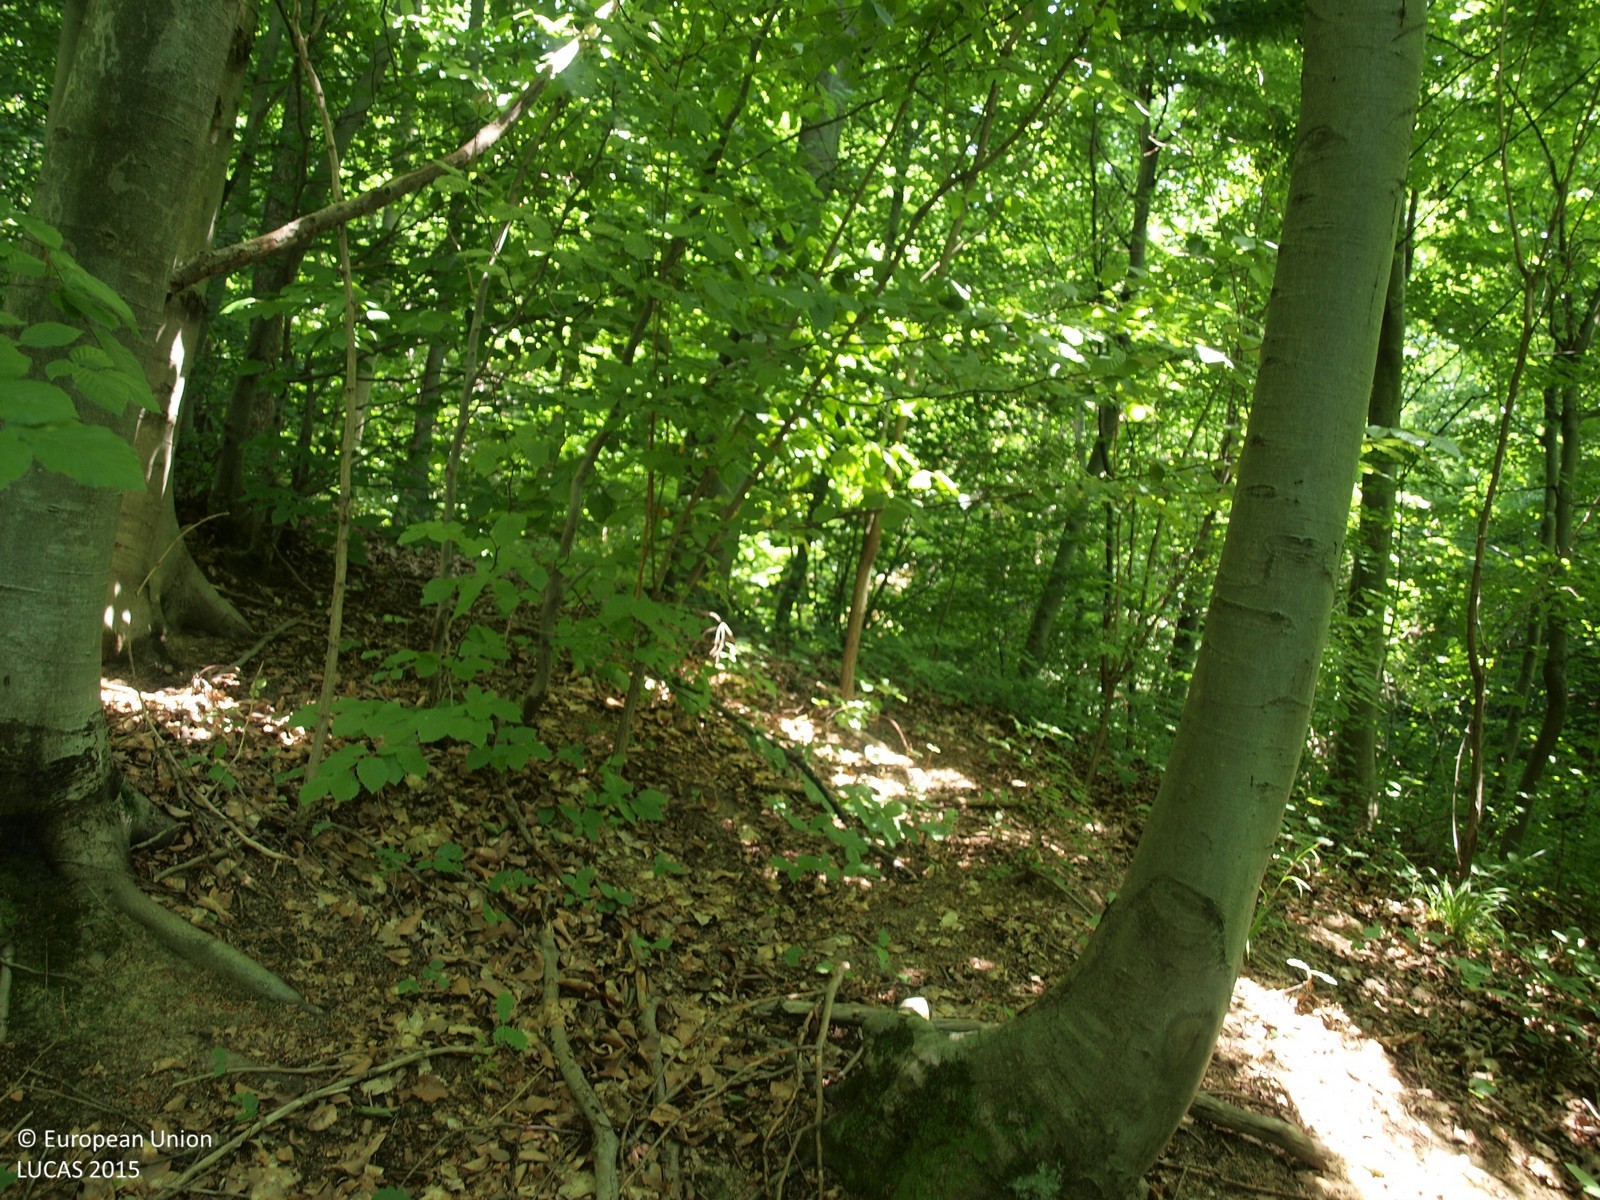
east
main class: Woodland
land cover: Broadleaved woodland
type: beech forest
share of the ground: > 75 %
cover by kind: broadleaved forest trees 100 %
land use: Forestry
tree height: > 5 m
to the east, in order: Broadleaved woodland; Artificial constructions in urban areas; Electric lines; Paved roads, cycling and walking lanes; Broadleaved woodland
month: July
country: HR
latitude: 45.7455
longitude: 15.7428
